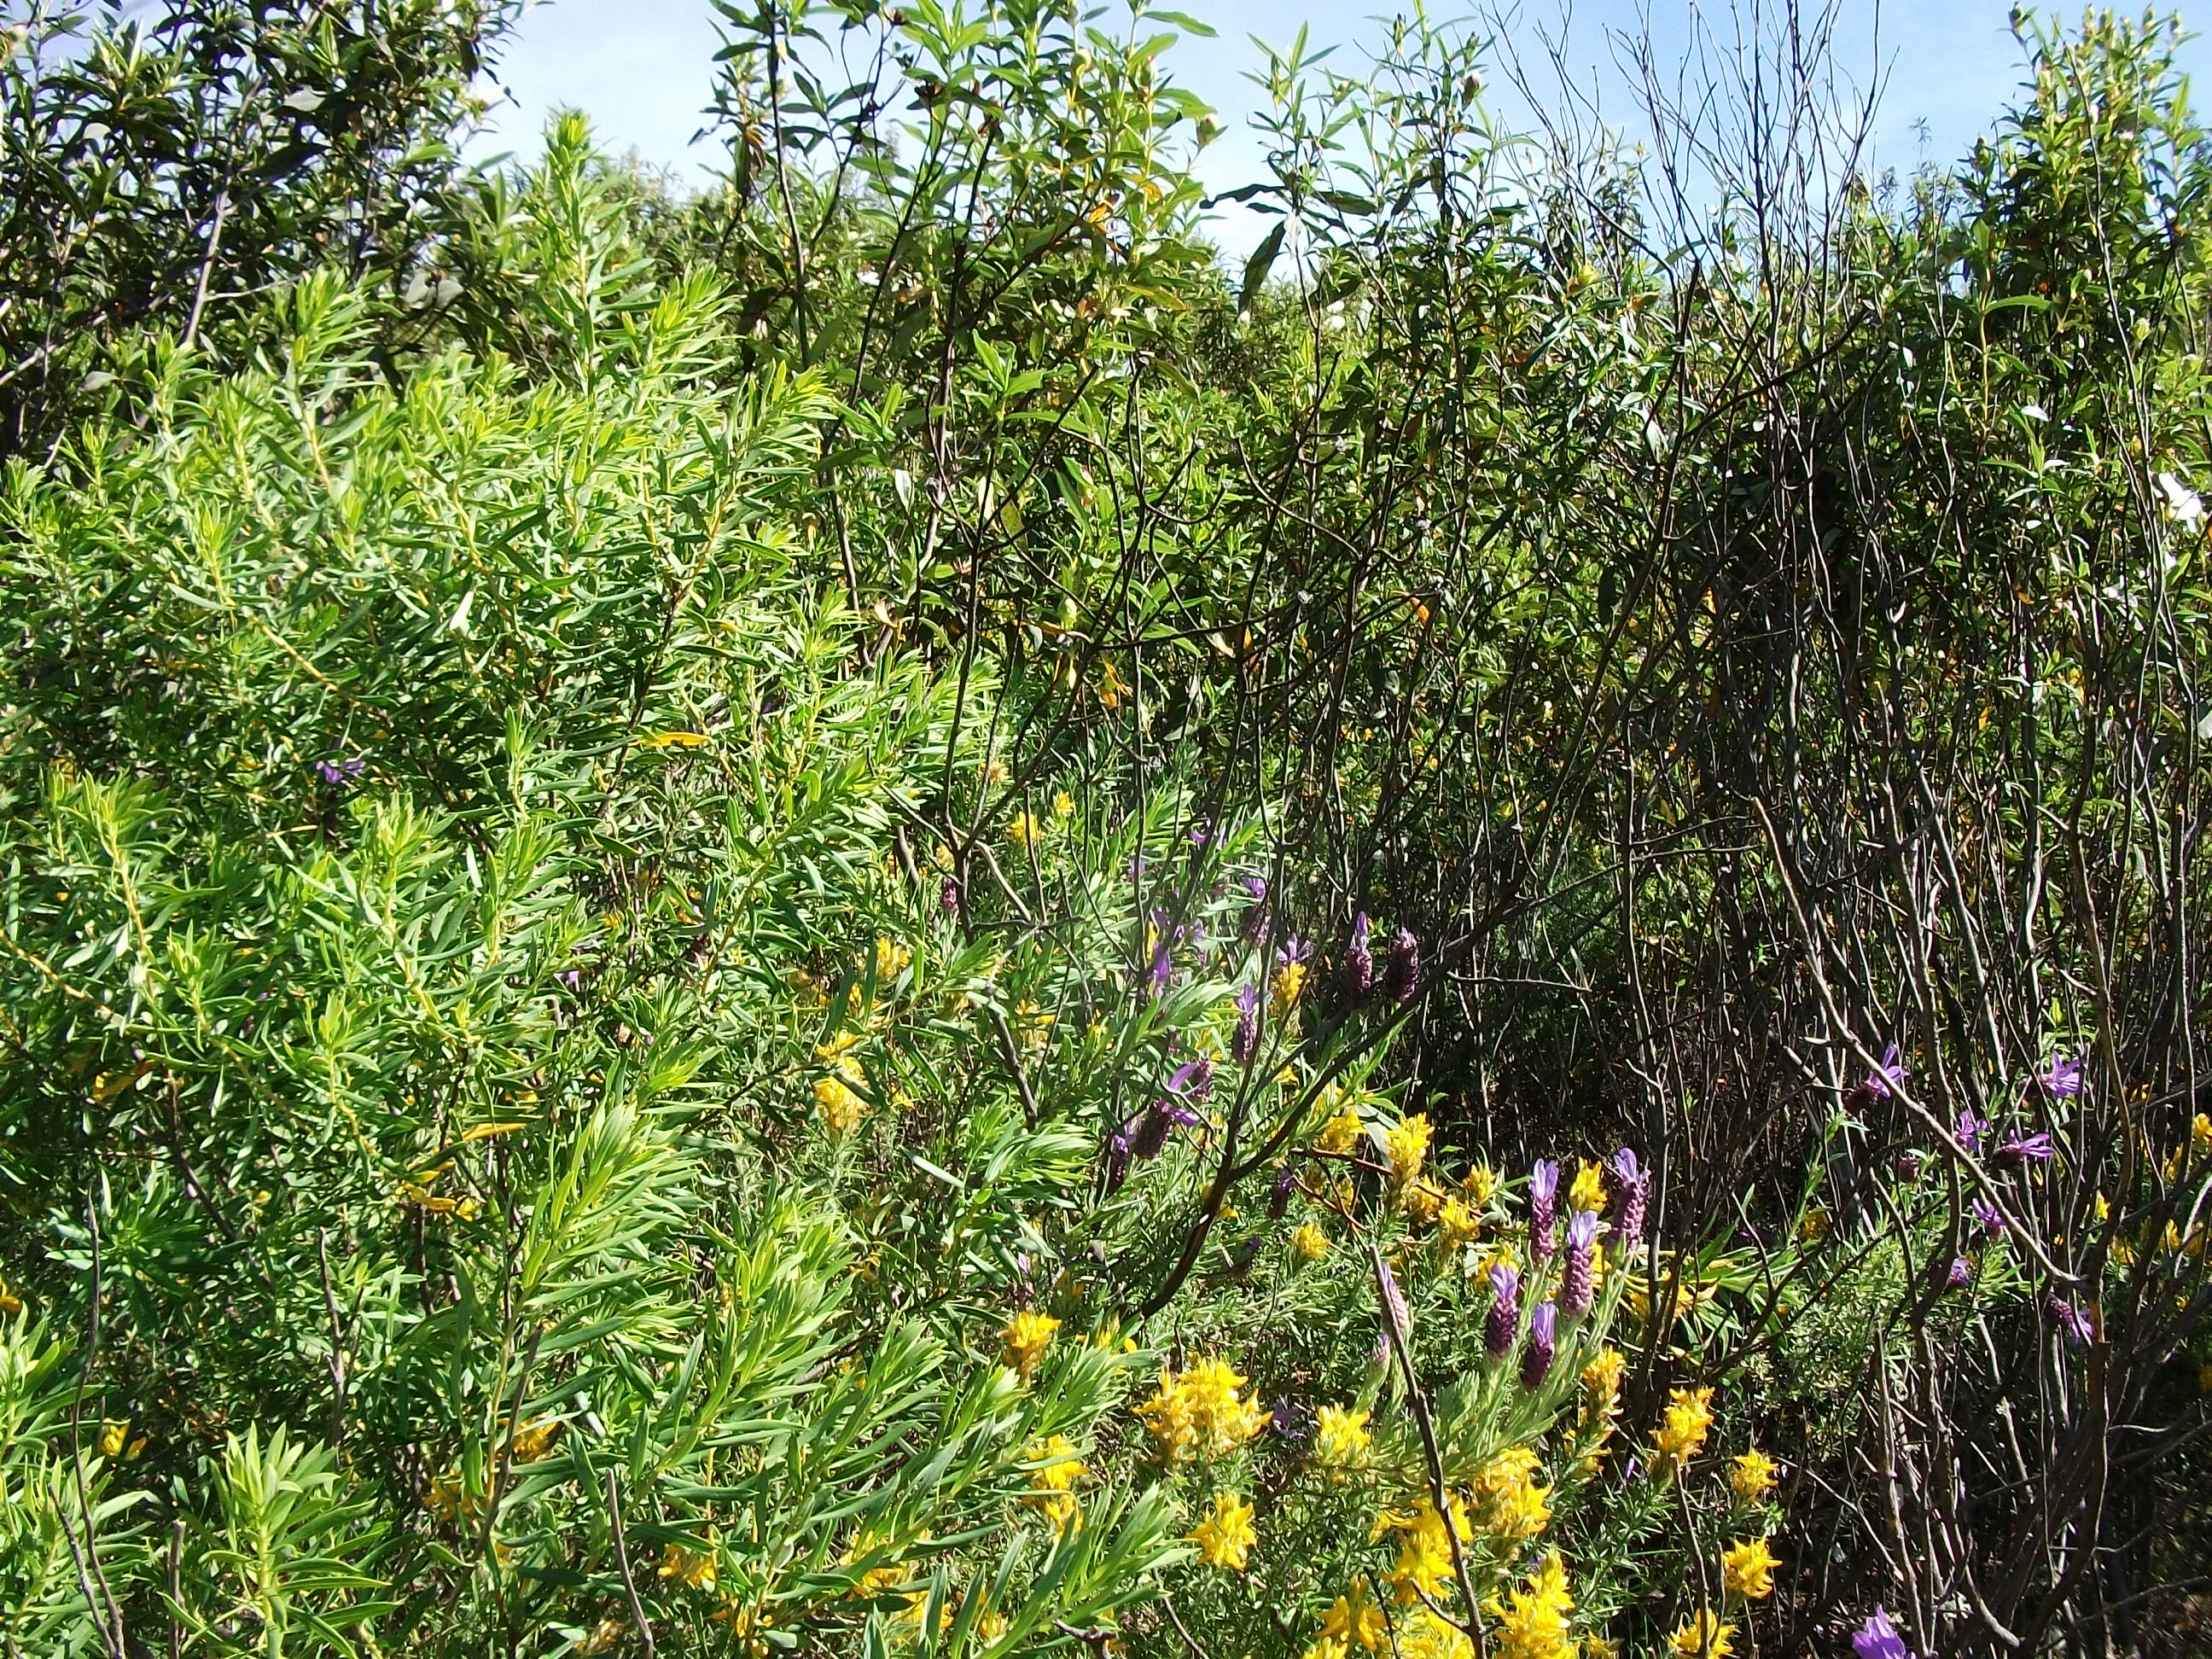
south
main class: Shrubland
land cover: Shrubland without tree cover
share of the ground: > 75 %
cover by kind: shrubs 100 %
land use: Semi-natural and natural areas not in use
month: April
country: ES
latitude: 37.6380
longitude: -6.5265
